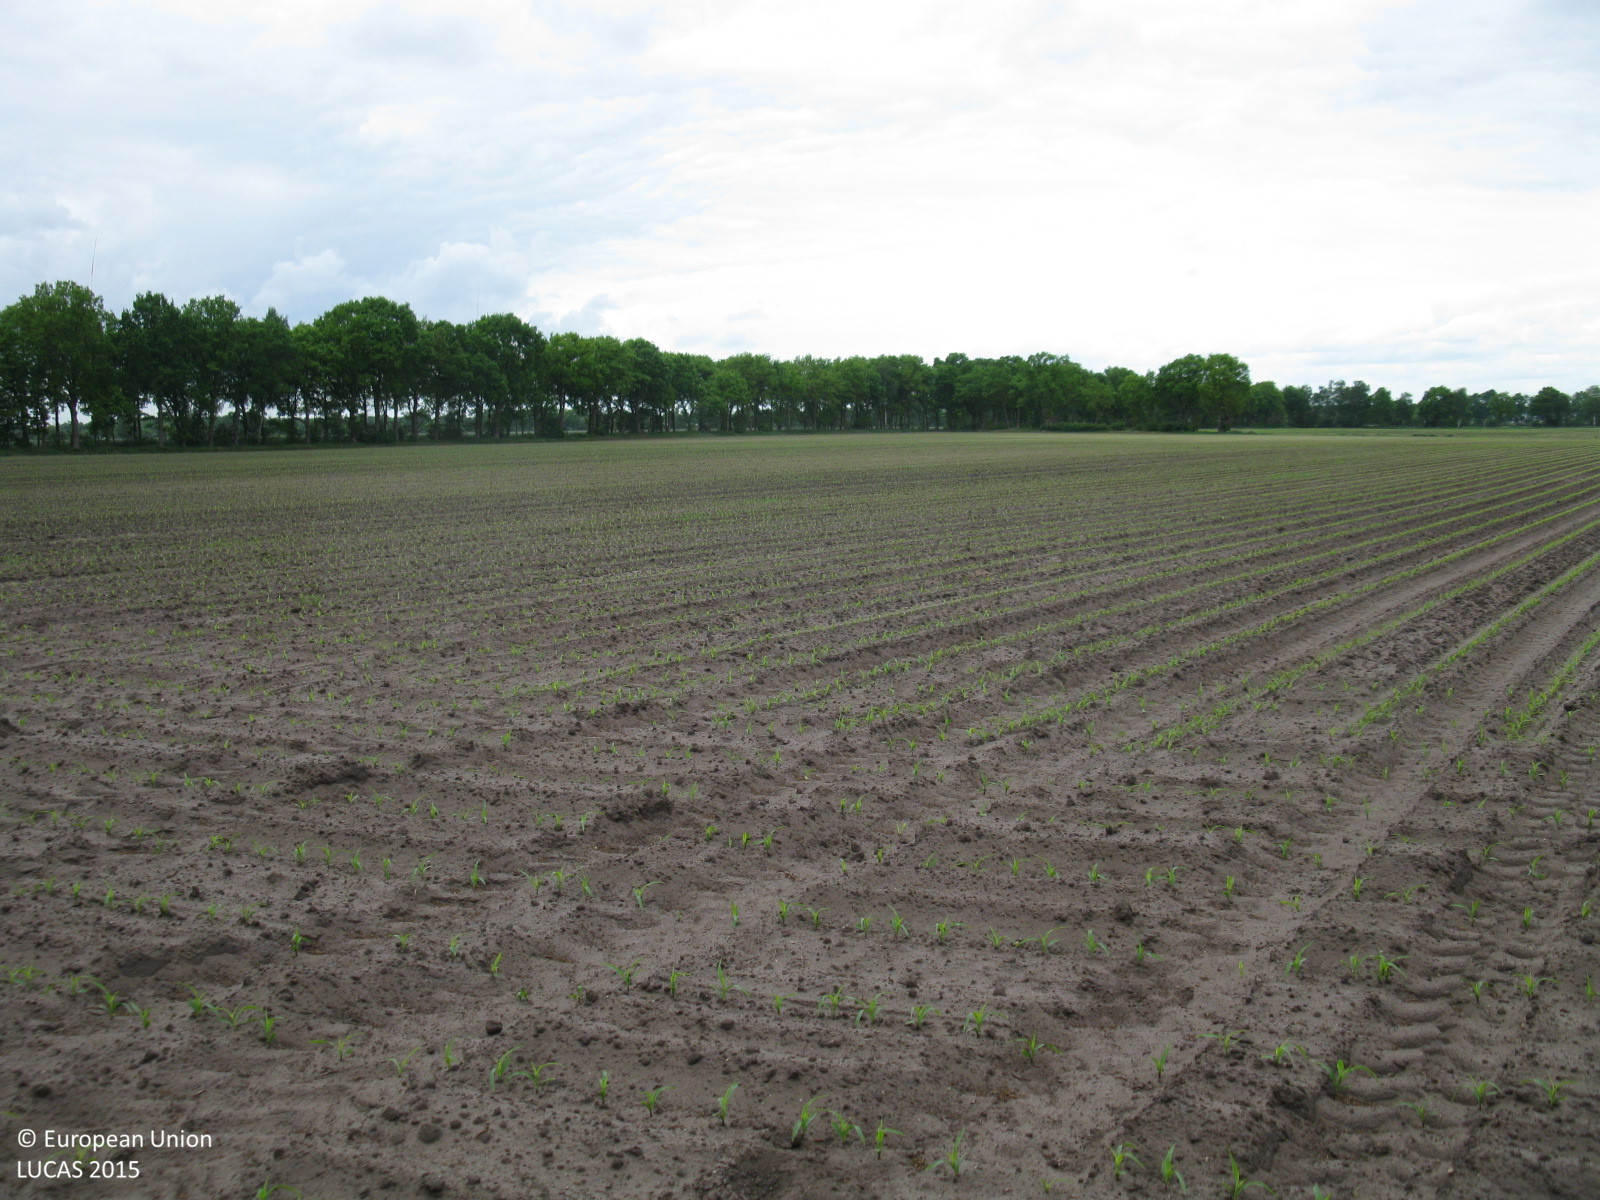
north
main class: Cropland
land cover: Maize
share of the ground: < 10 %
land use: Agriculture (excluding fallow land and kitchen gardens)
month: May
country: DE
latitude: 52.9708
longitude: 7.9308
